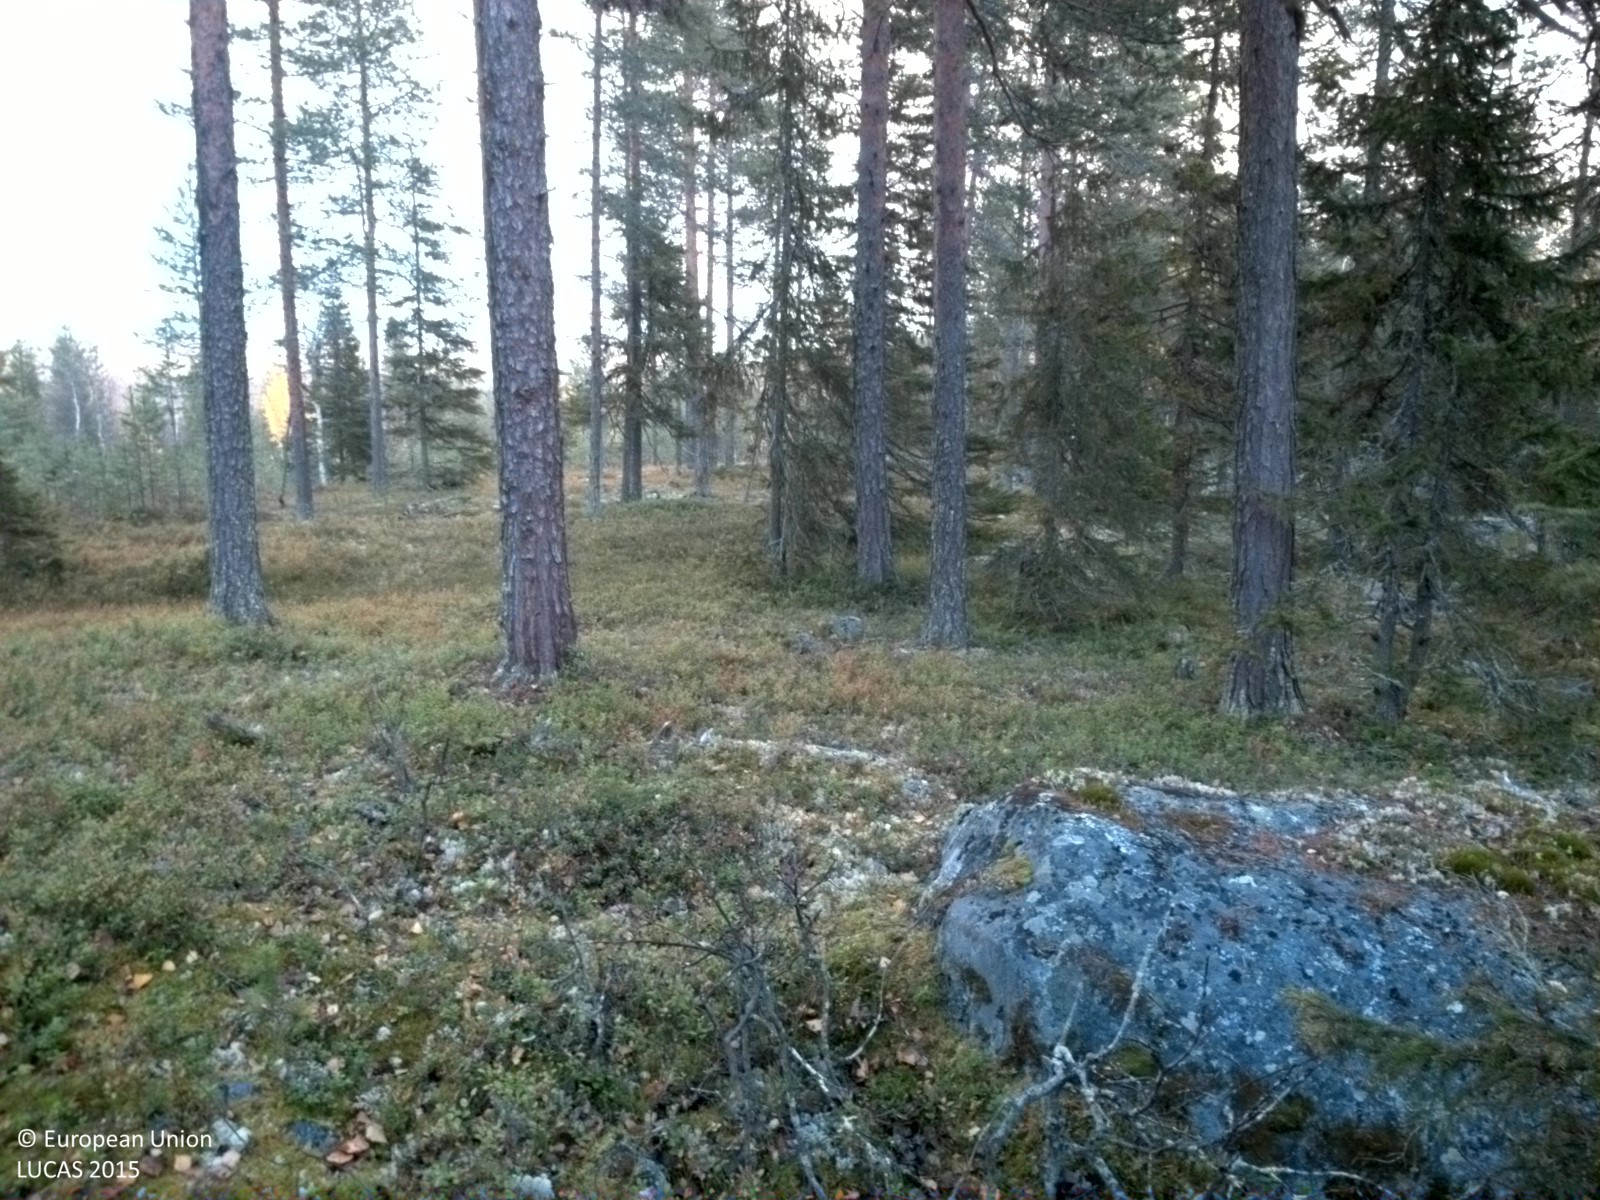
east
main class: Woodland
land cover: Pine dominated coniferous woodland
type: boreal forest
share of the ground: 25 - 50 %
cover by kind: shrubs 50 %, coniferous forest trees 30 %, lichens and mosses 10 %, consolidated bare surface 10 %
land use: Forestry
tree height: > 5 m
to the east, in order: Pine dominated coniferous woodland; Shrubland with sparse tree cover; Pine dominated coniferous woodland
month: October
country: SE
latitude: 65.9891
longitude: 22.0649
